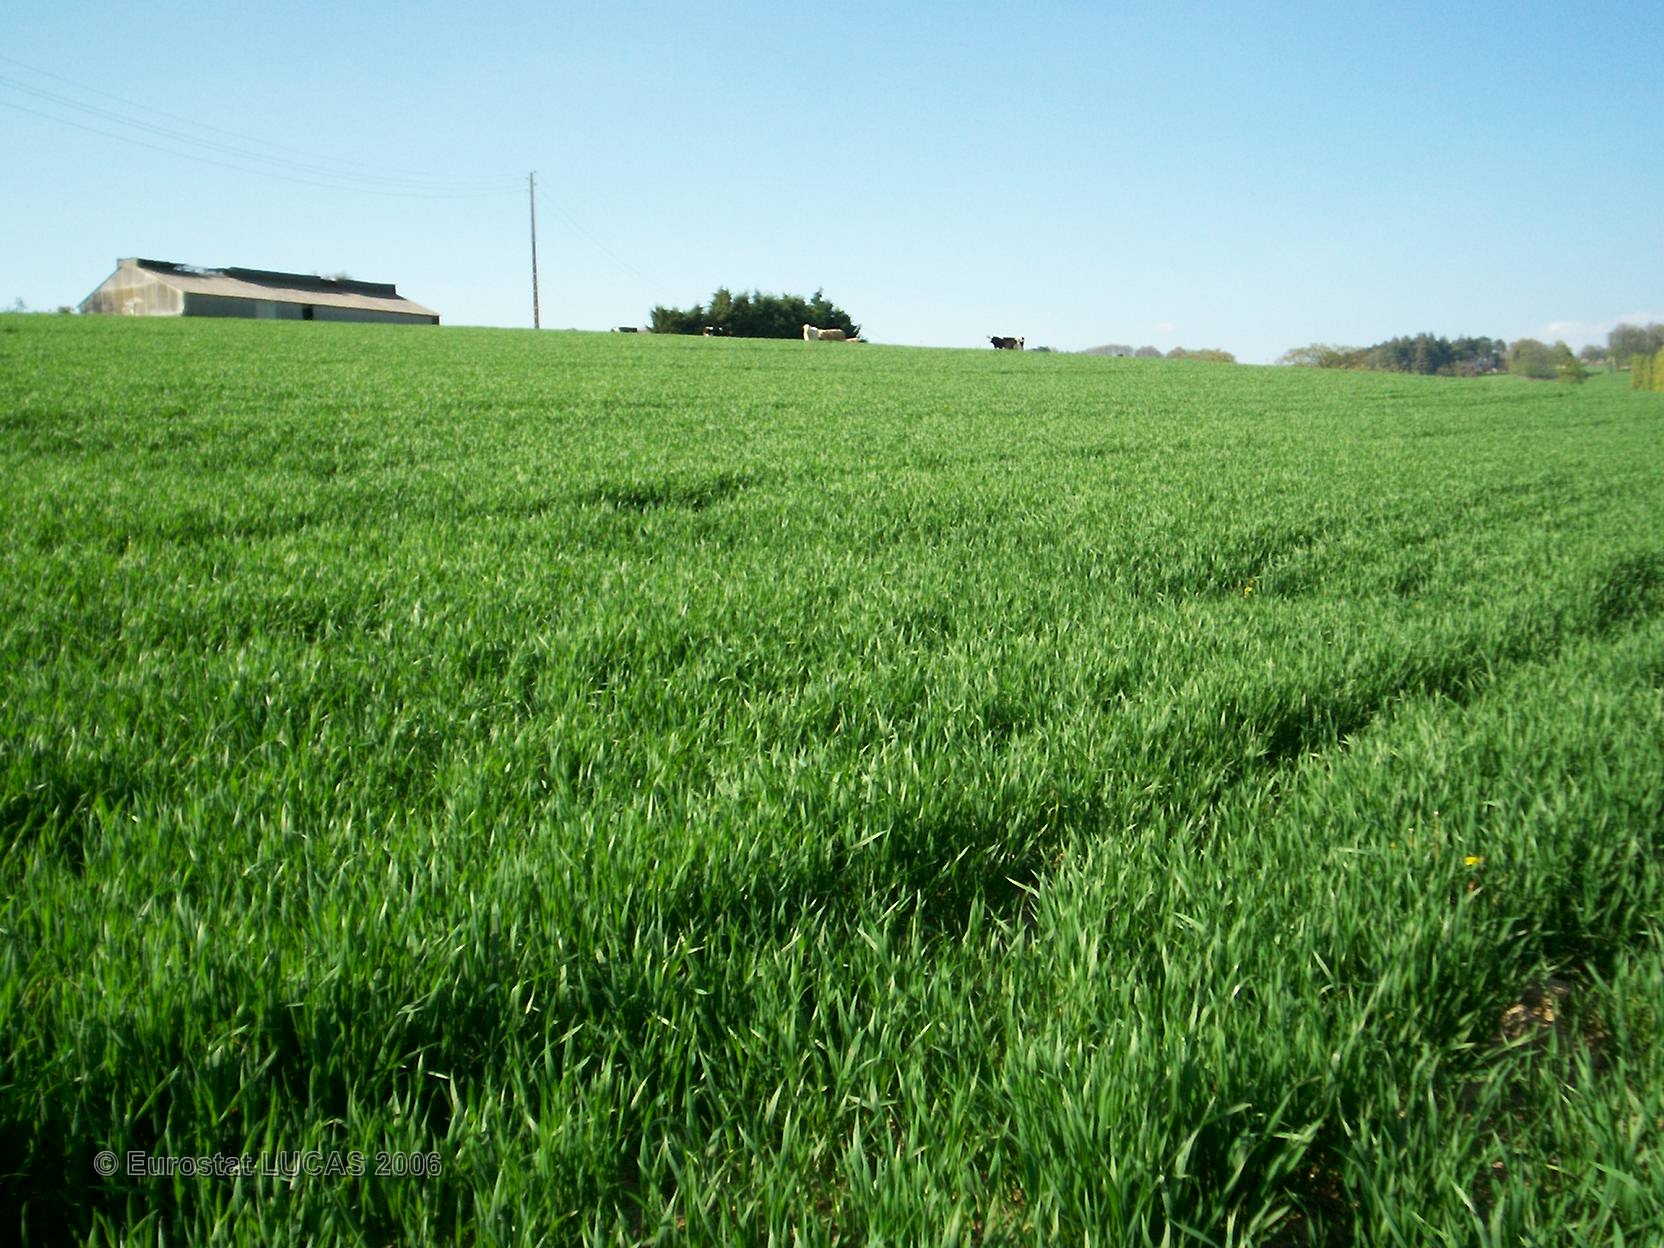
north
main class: Cropland
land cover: Common wheat
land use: Agriculture (excluding fallow land and kitchen gardens)
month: May
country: FR
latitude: 48.2168
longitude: -1.1723
